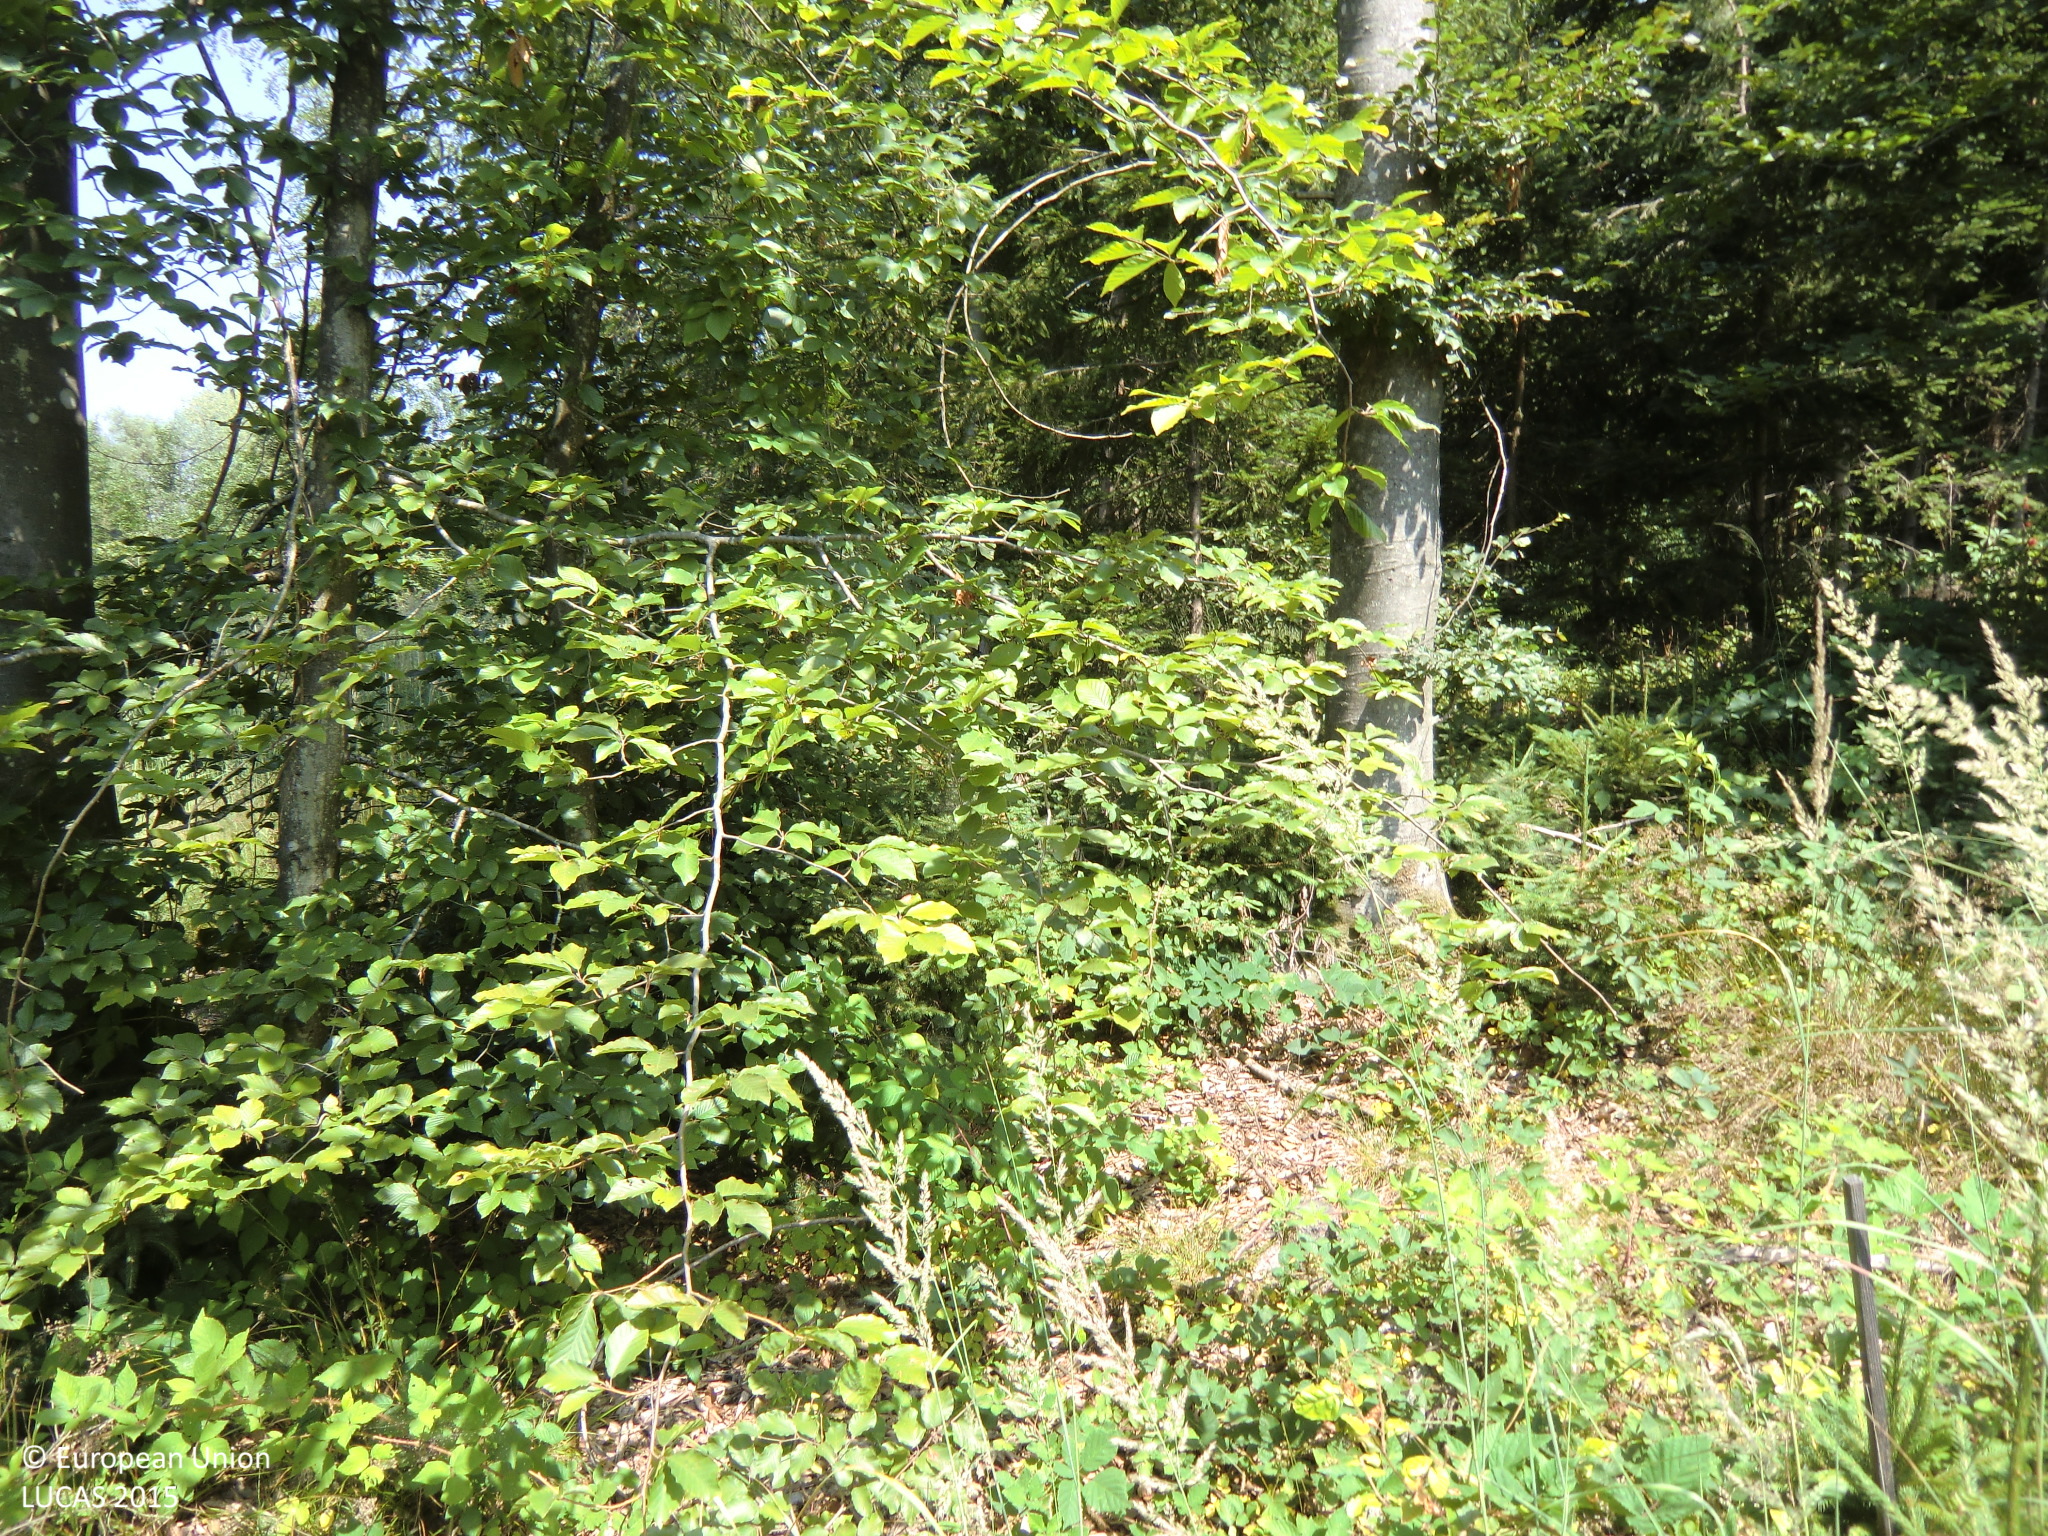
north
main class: Shrubland
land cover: Shrubland with sparse tree cover
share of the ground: > 75 %
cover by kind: herbaceous plants 55 %, shrubs 40 %, broadleaved forest trees 5 %
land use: Forestry
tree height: < 5 m
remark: Clear cut
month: July
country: AT
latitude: 47.1001
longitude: 15.7320
